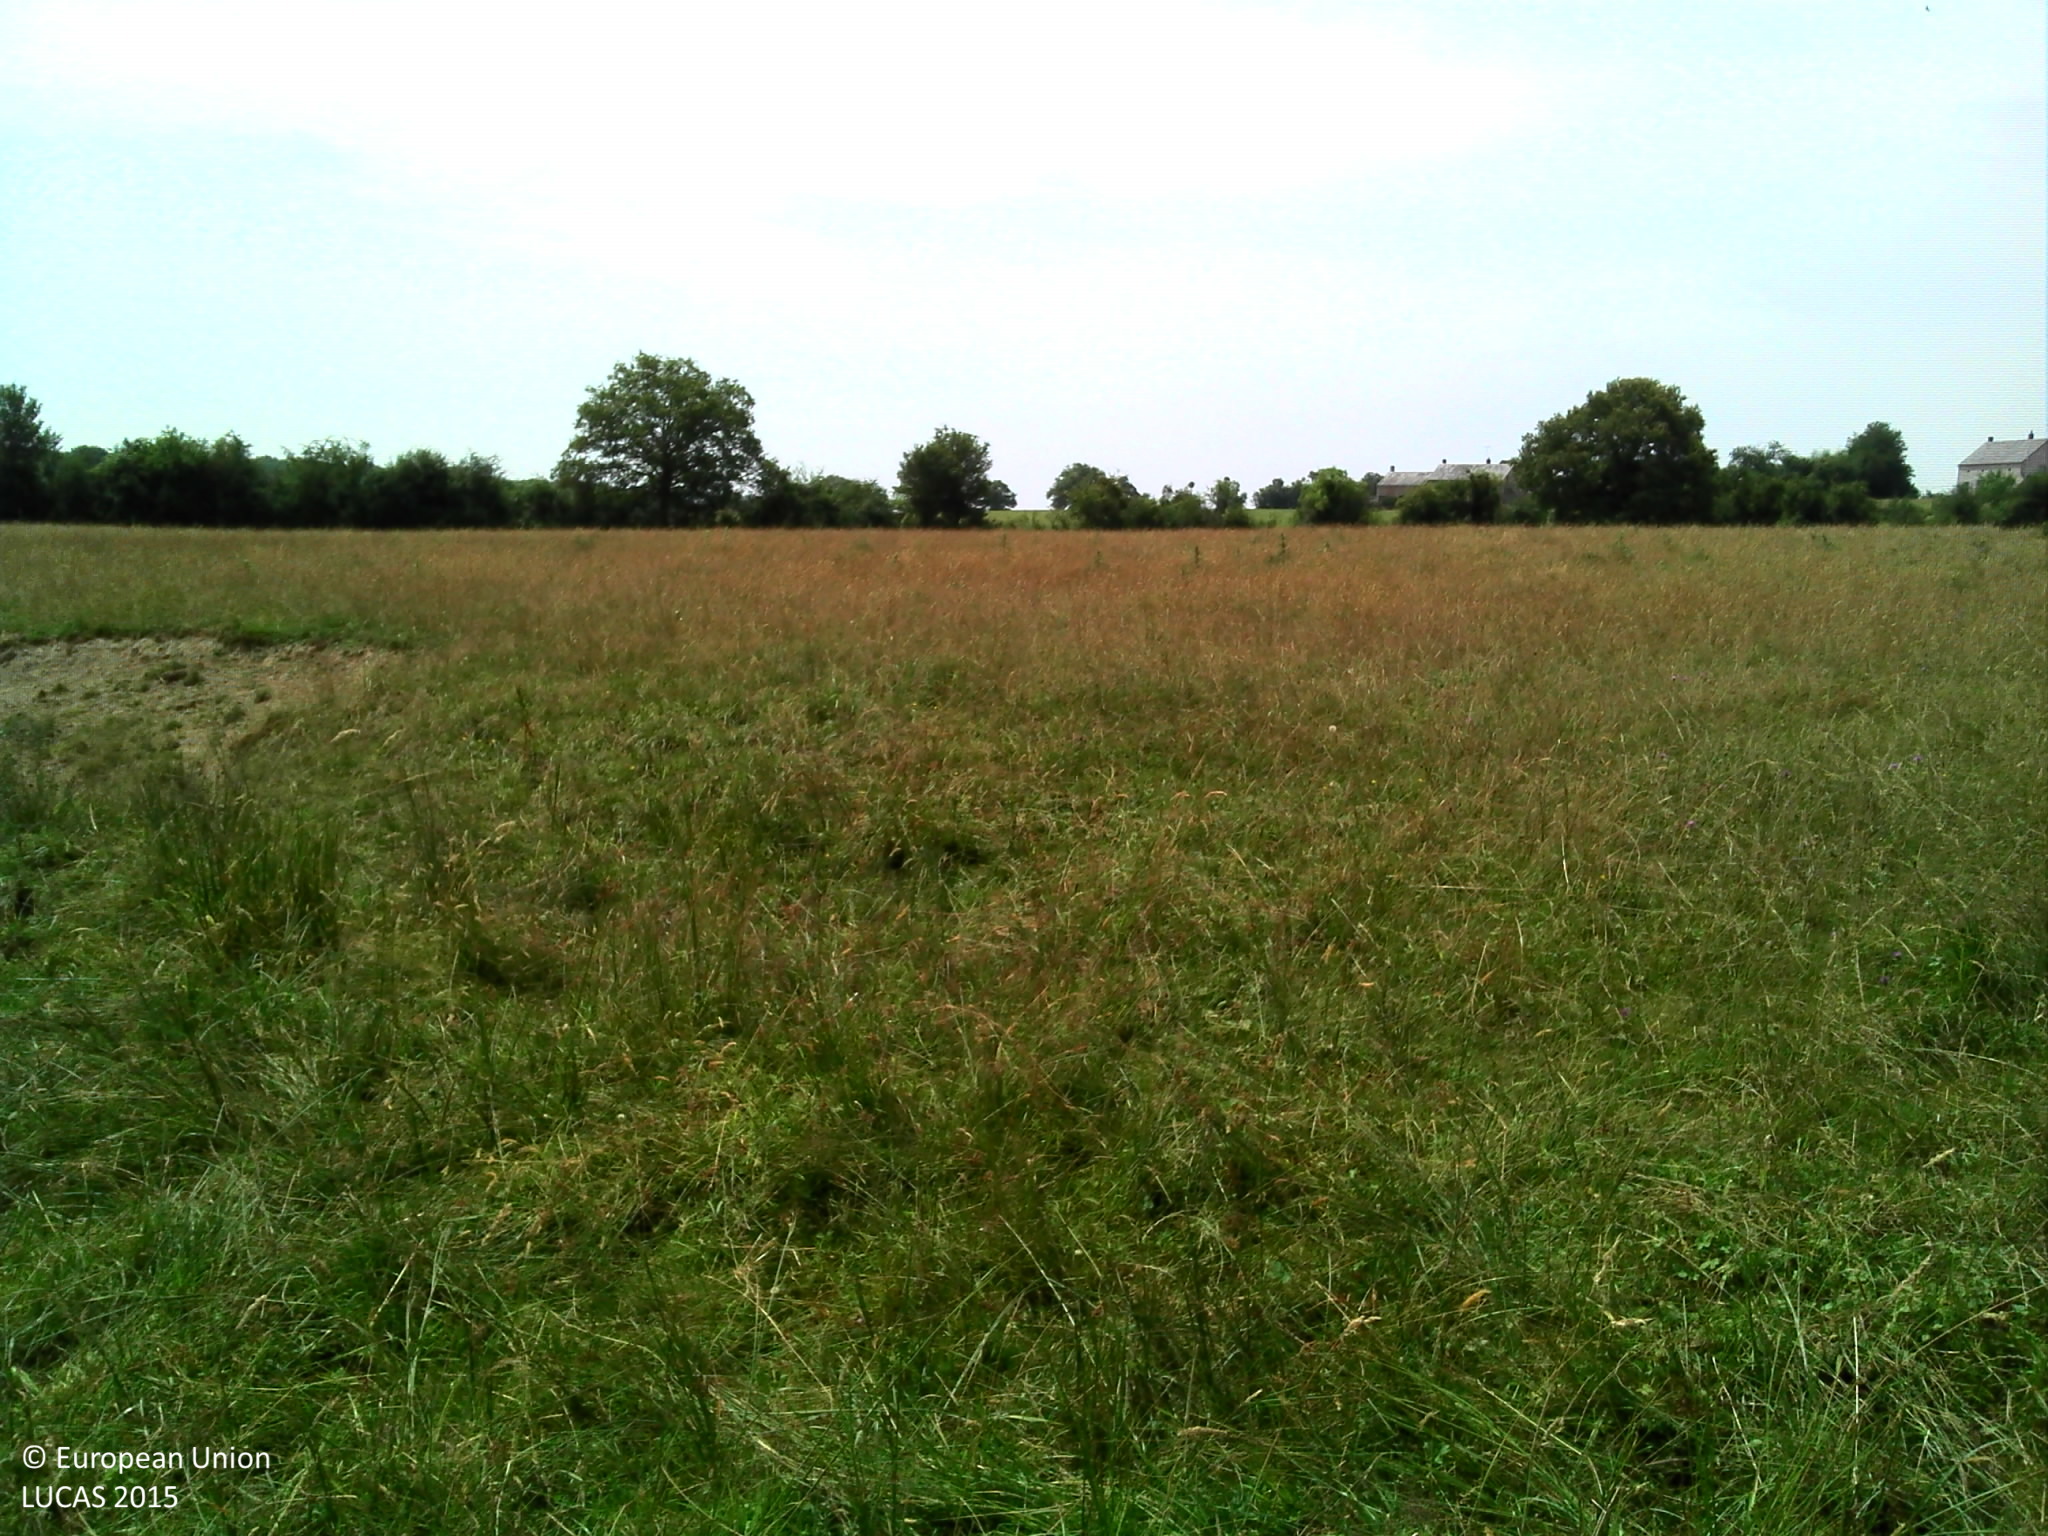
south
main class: Grassland
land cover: Grassland without tree/shrub cover
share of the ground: > 75 %
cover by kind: herbaceous plants 100 %
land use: Agriculture (excluding fallow land and kitchen gardens)
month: July
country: FR
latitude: 47.0766
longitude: 3.5310
